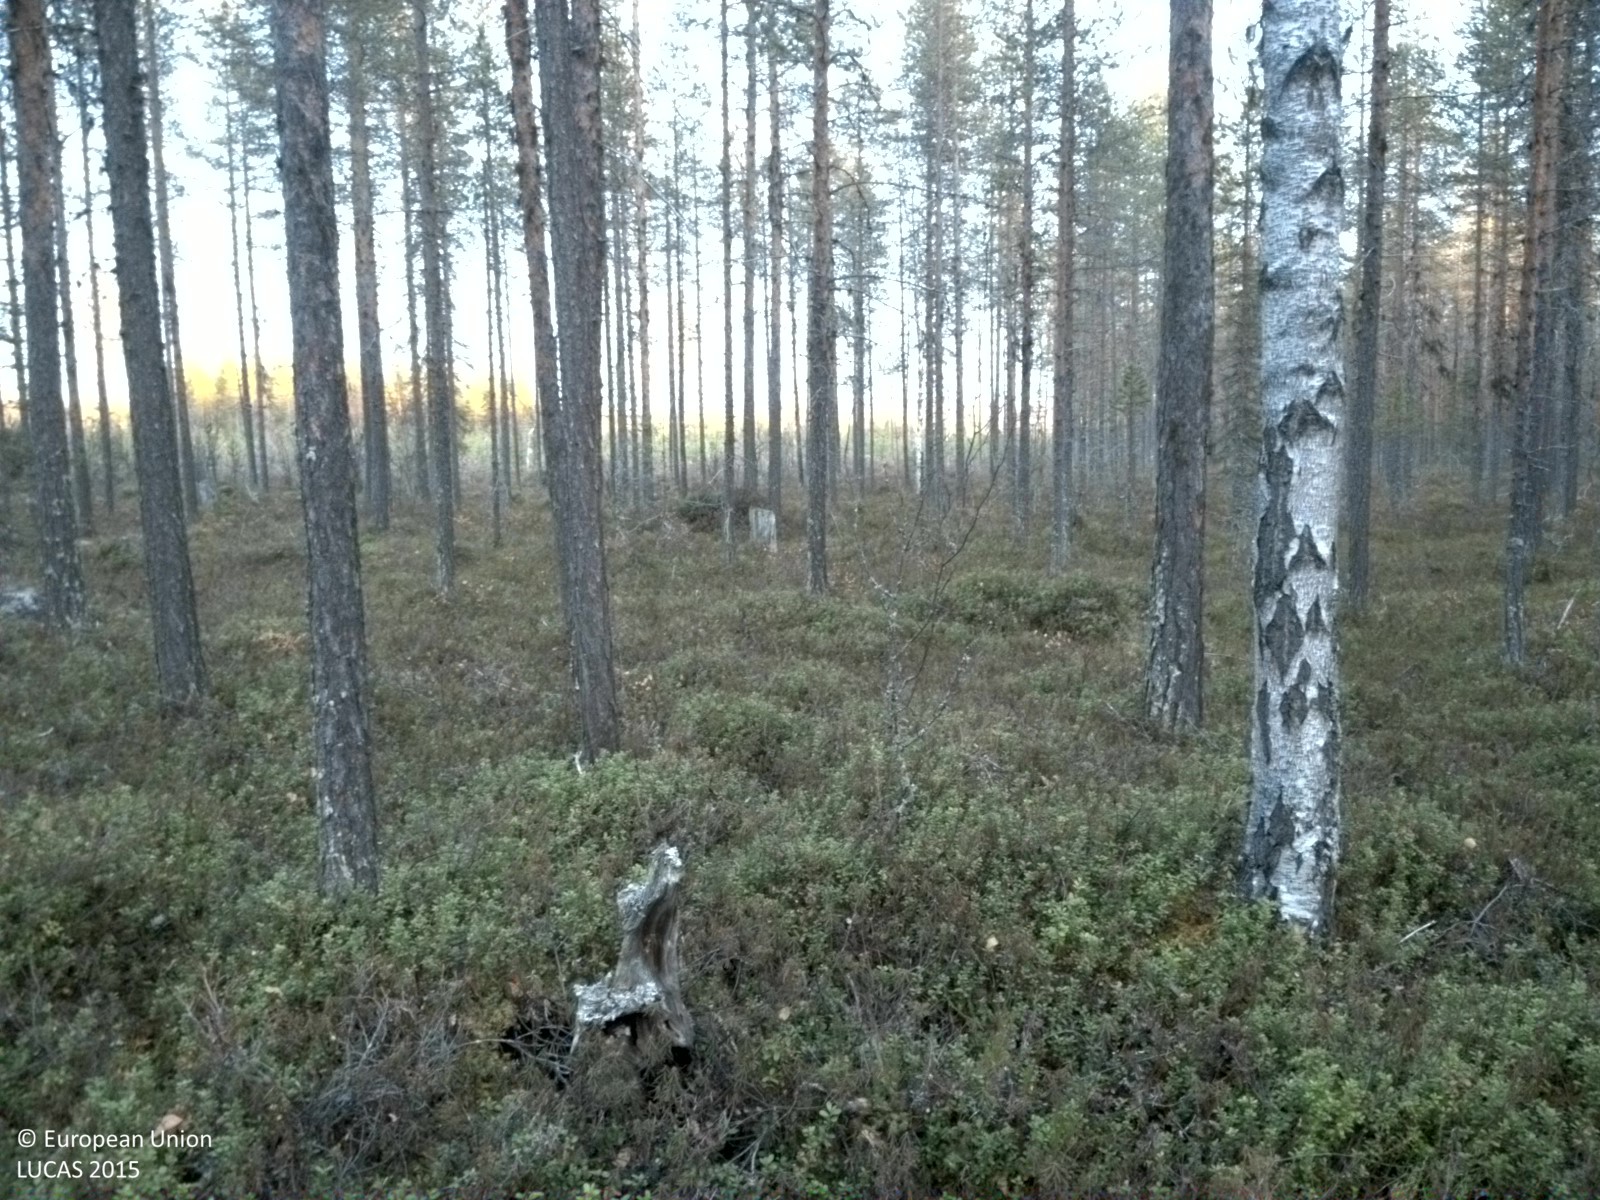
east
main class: Woodland
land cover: Pine dominated coniferous woodland
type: boreal forest
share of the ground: 25 - 50 %
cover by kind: shrubs 70 %, coniferous forest trees 30 %
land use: Forestry
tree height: > 5 m
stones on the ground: > 50 %
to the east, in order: Pine dominated coniferous woodland
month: October
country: SE
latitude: 65.8776
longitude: 20.4665
